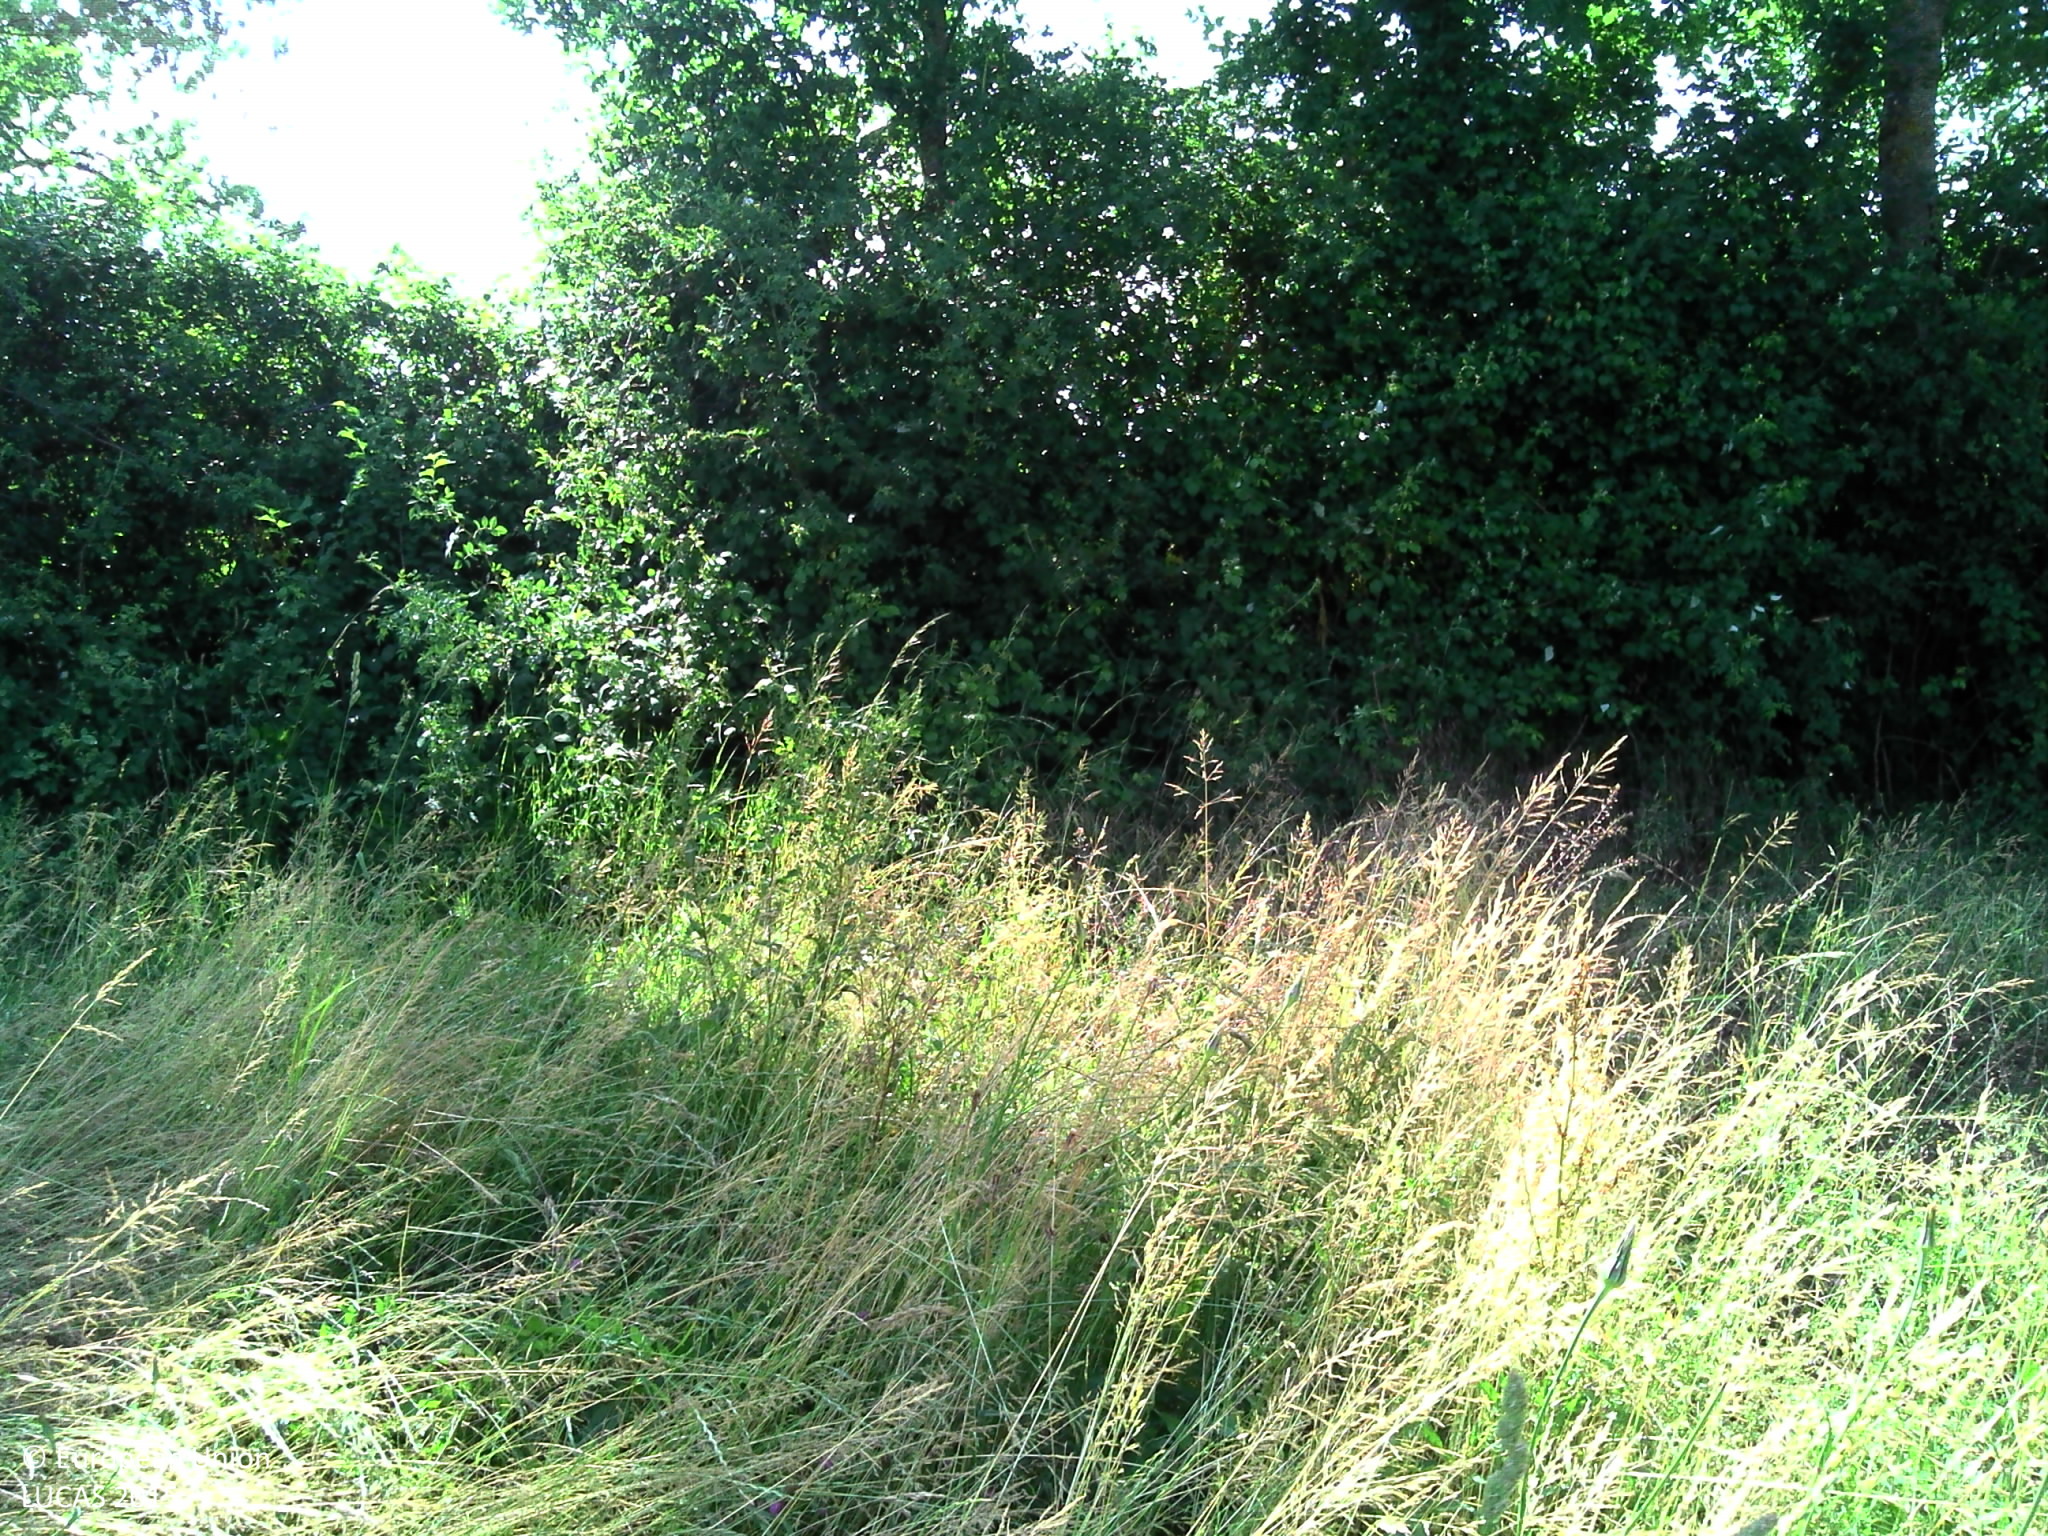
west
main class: Grassland
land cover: Grassland without tree/shrub cover
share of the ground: > 75 %
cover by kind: herbaceous plants 95 %, shrubs 5 %
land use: Agriculture (excluding fallow land and kitchen gardens)
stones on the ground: 10 - 25 %
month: June
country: FR
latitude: 44.3291
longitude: 2.9695
